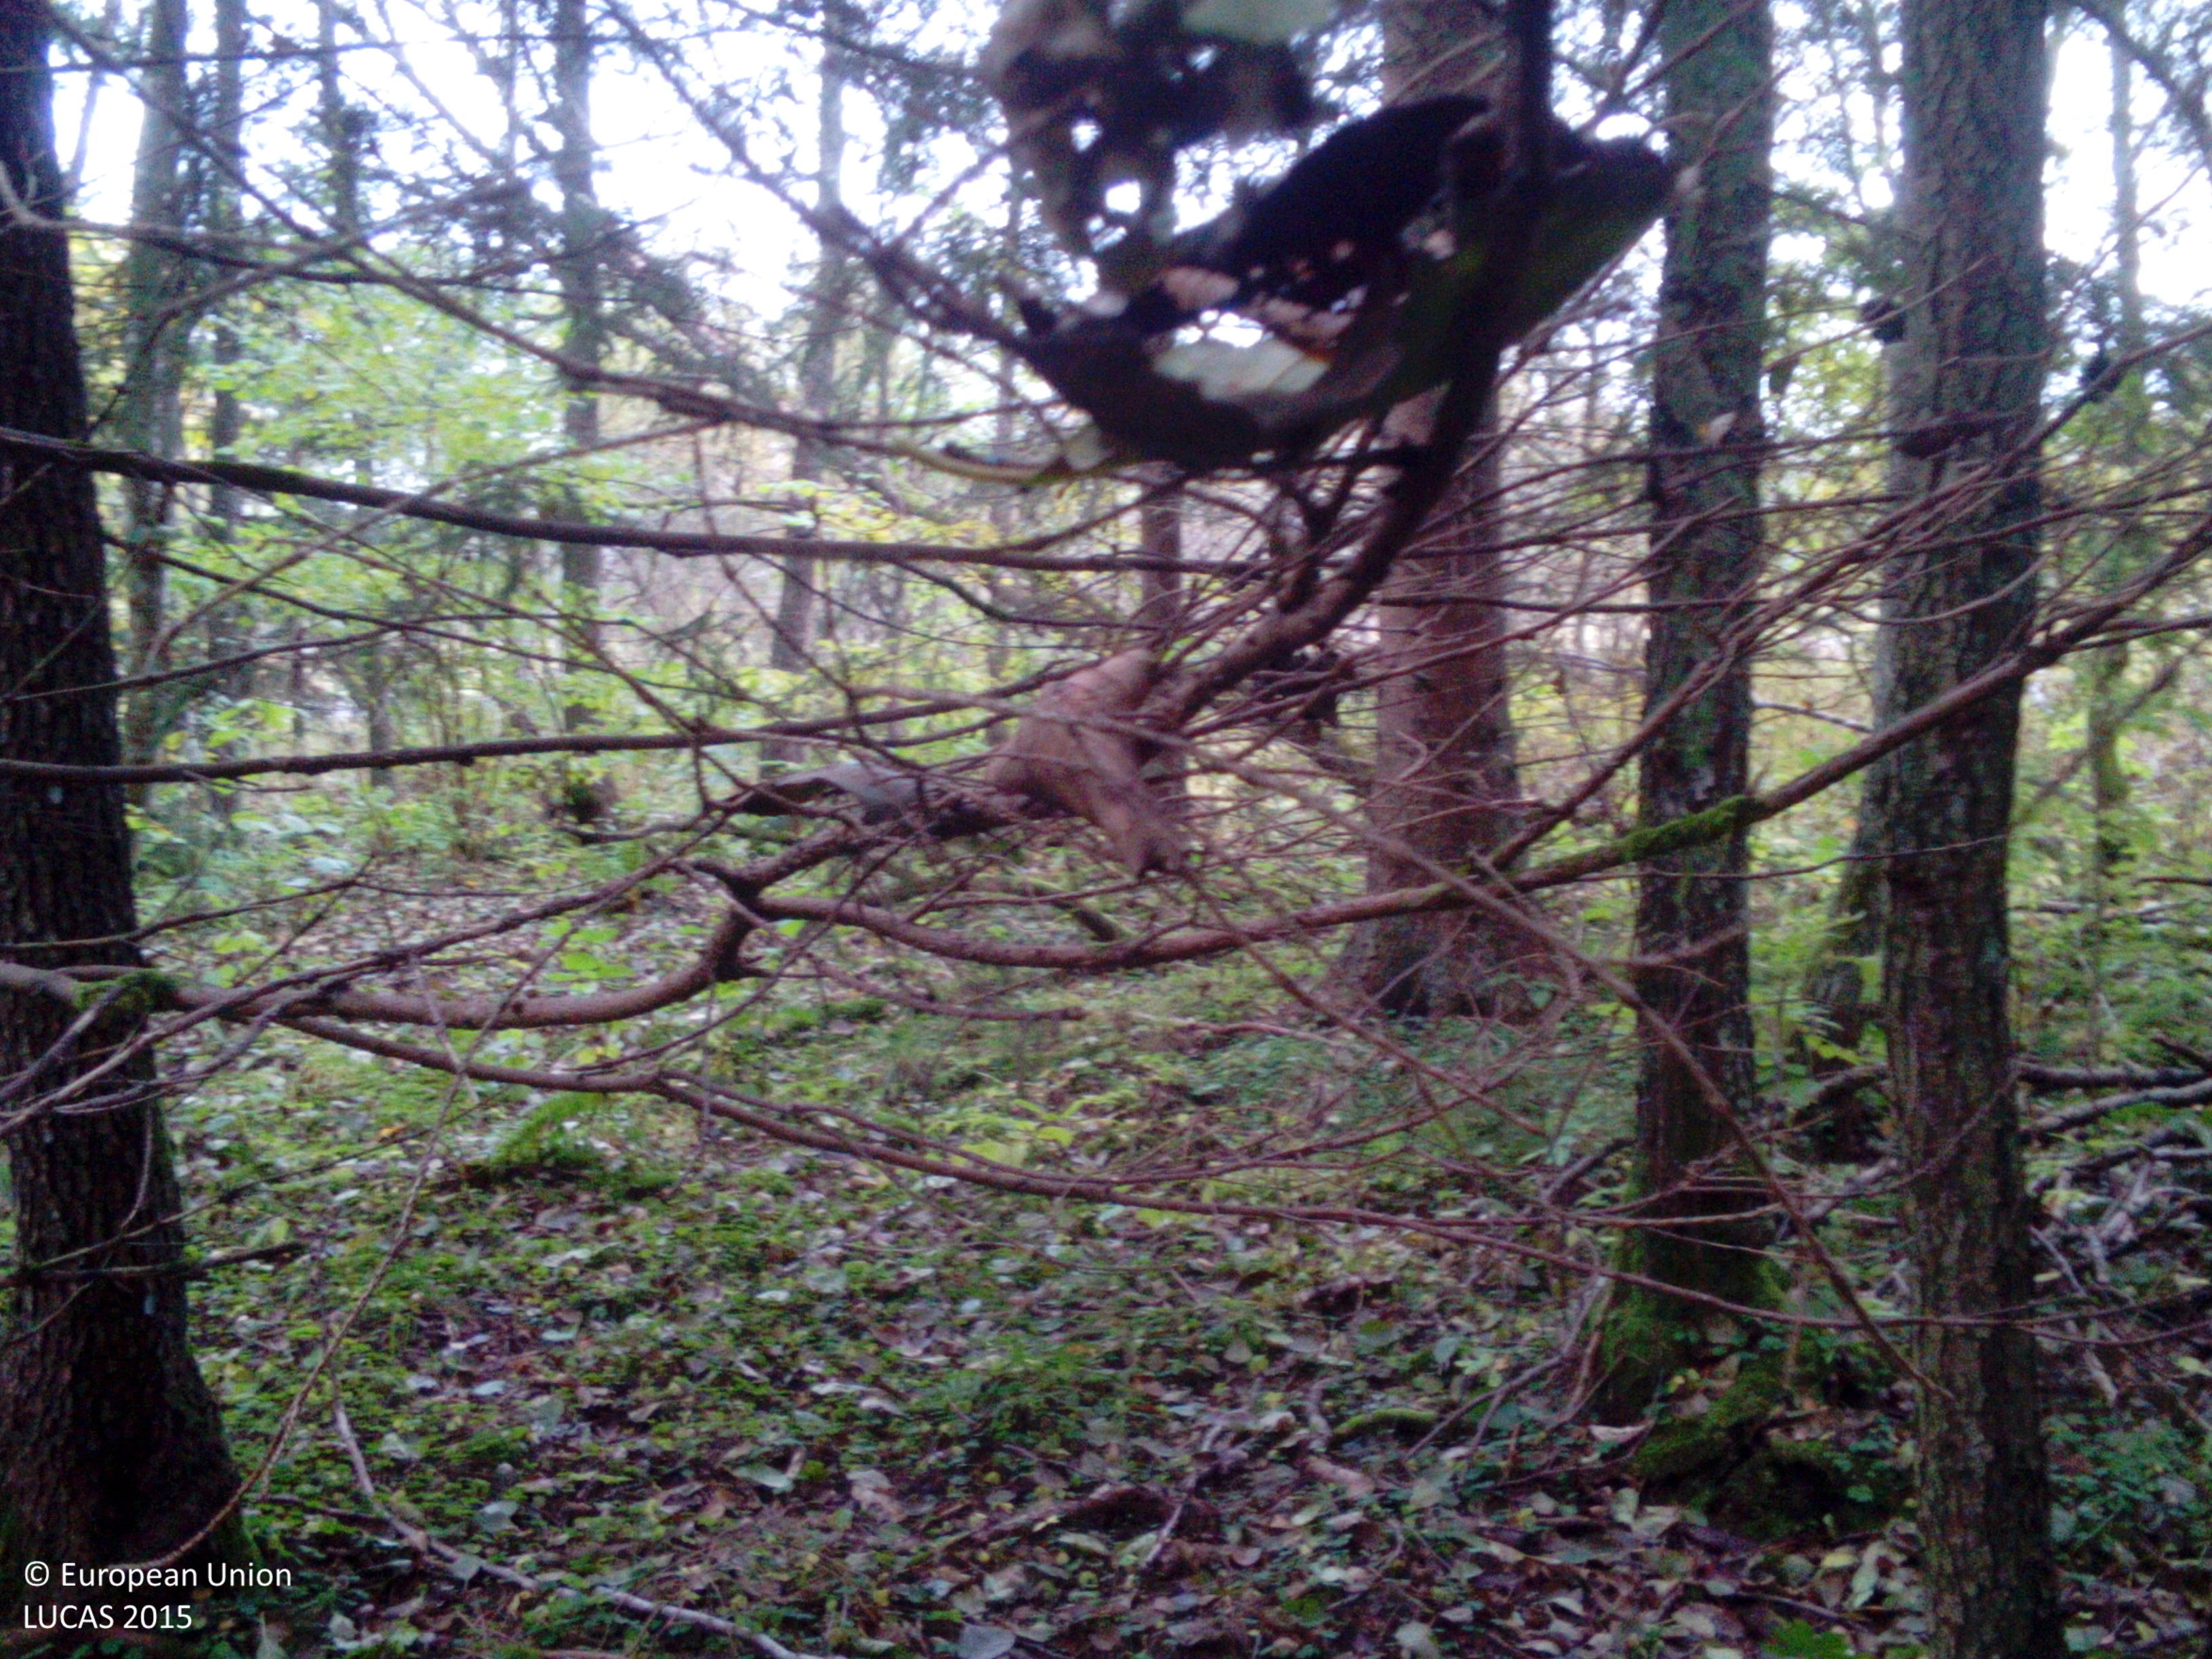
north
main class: Woodland
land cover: Spruce dominated mixed woodland
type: boreal forest
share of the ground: > 75 %
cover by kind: coniferous forest trees 55 %, broadleaved forest trees 35 %, herbaceous plants 10 %
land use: Forestry
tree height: > 5 m
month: October
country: SE
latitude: 59.2784
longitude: 16.3635
